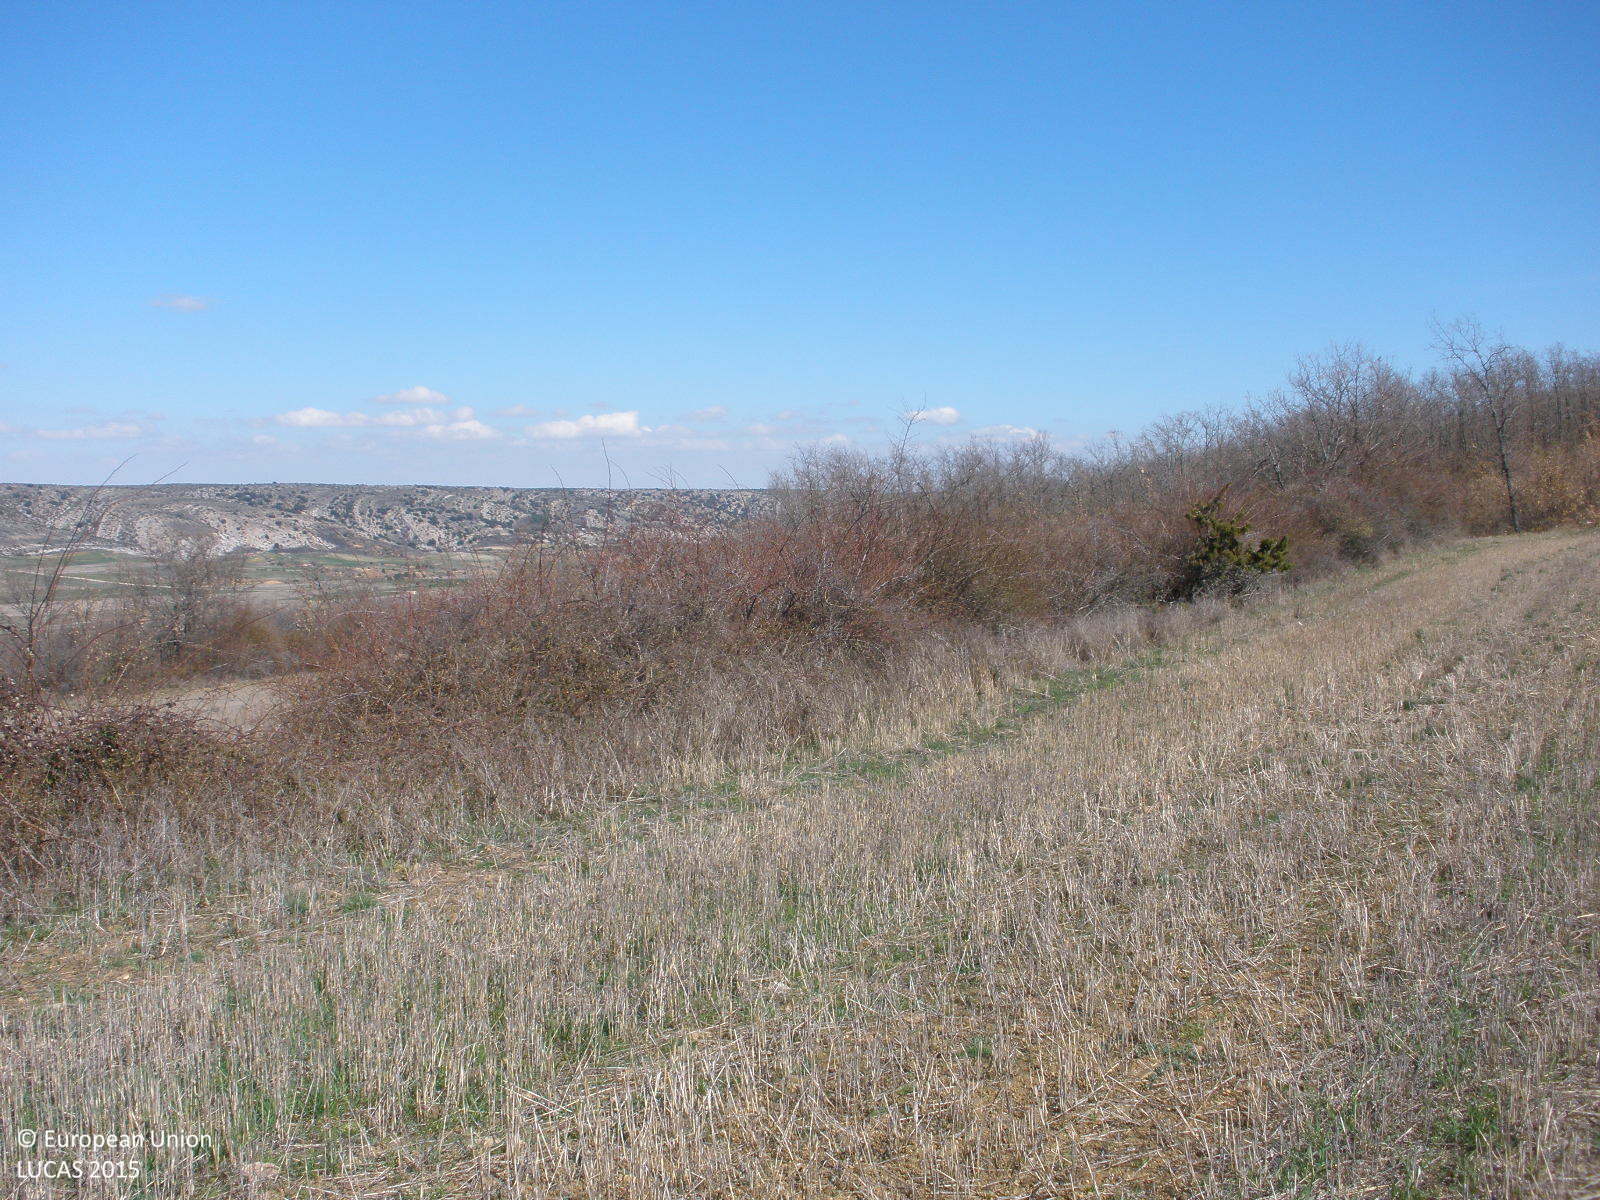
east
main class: Grassland
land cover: Spontaneously vegetated surfaces
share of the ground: 50 - 75 %
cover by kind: herbaceous plants 70 %, unconsolidated bare surface 30 %
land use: Agriculture (excluding fallow land and kitchen gardens)
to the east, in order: Spontaneously vegetated surfaces; Broadleaved woodland; Spontaneously vegetated surfaces; Other mixed woodland
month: April
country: ES
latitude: 40.9871
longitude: -1.0830
